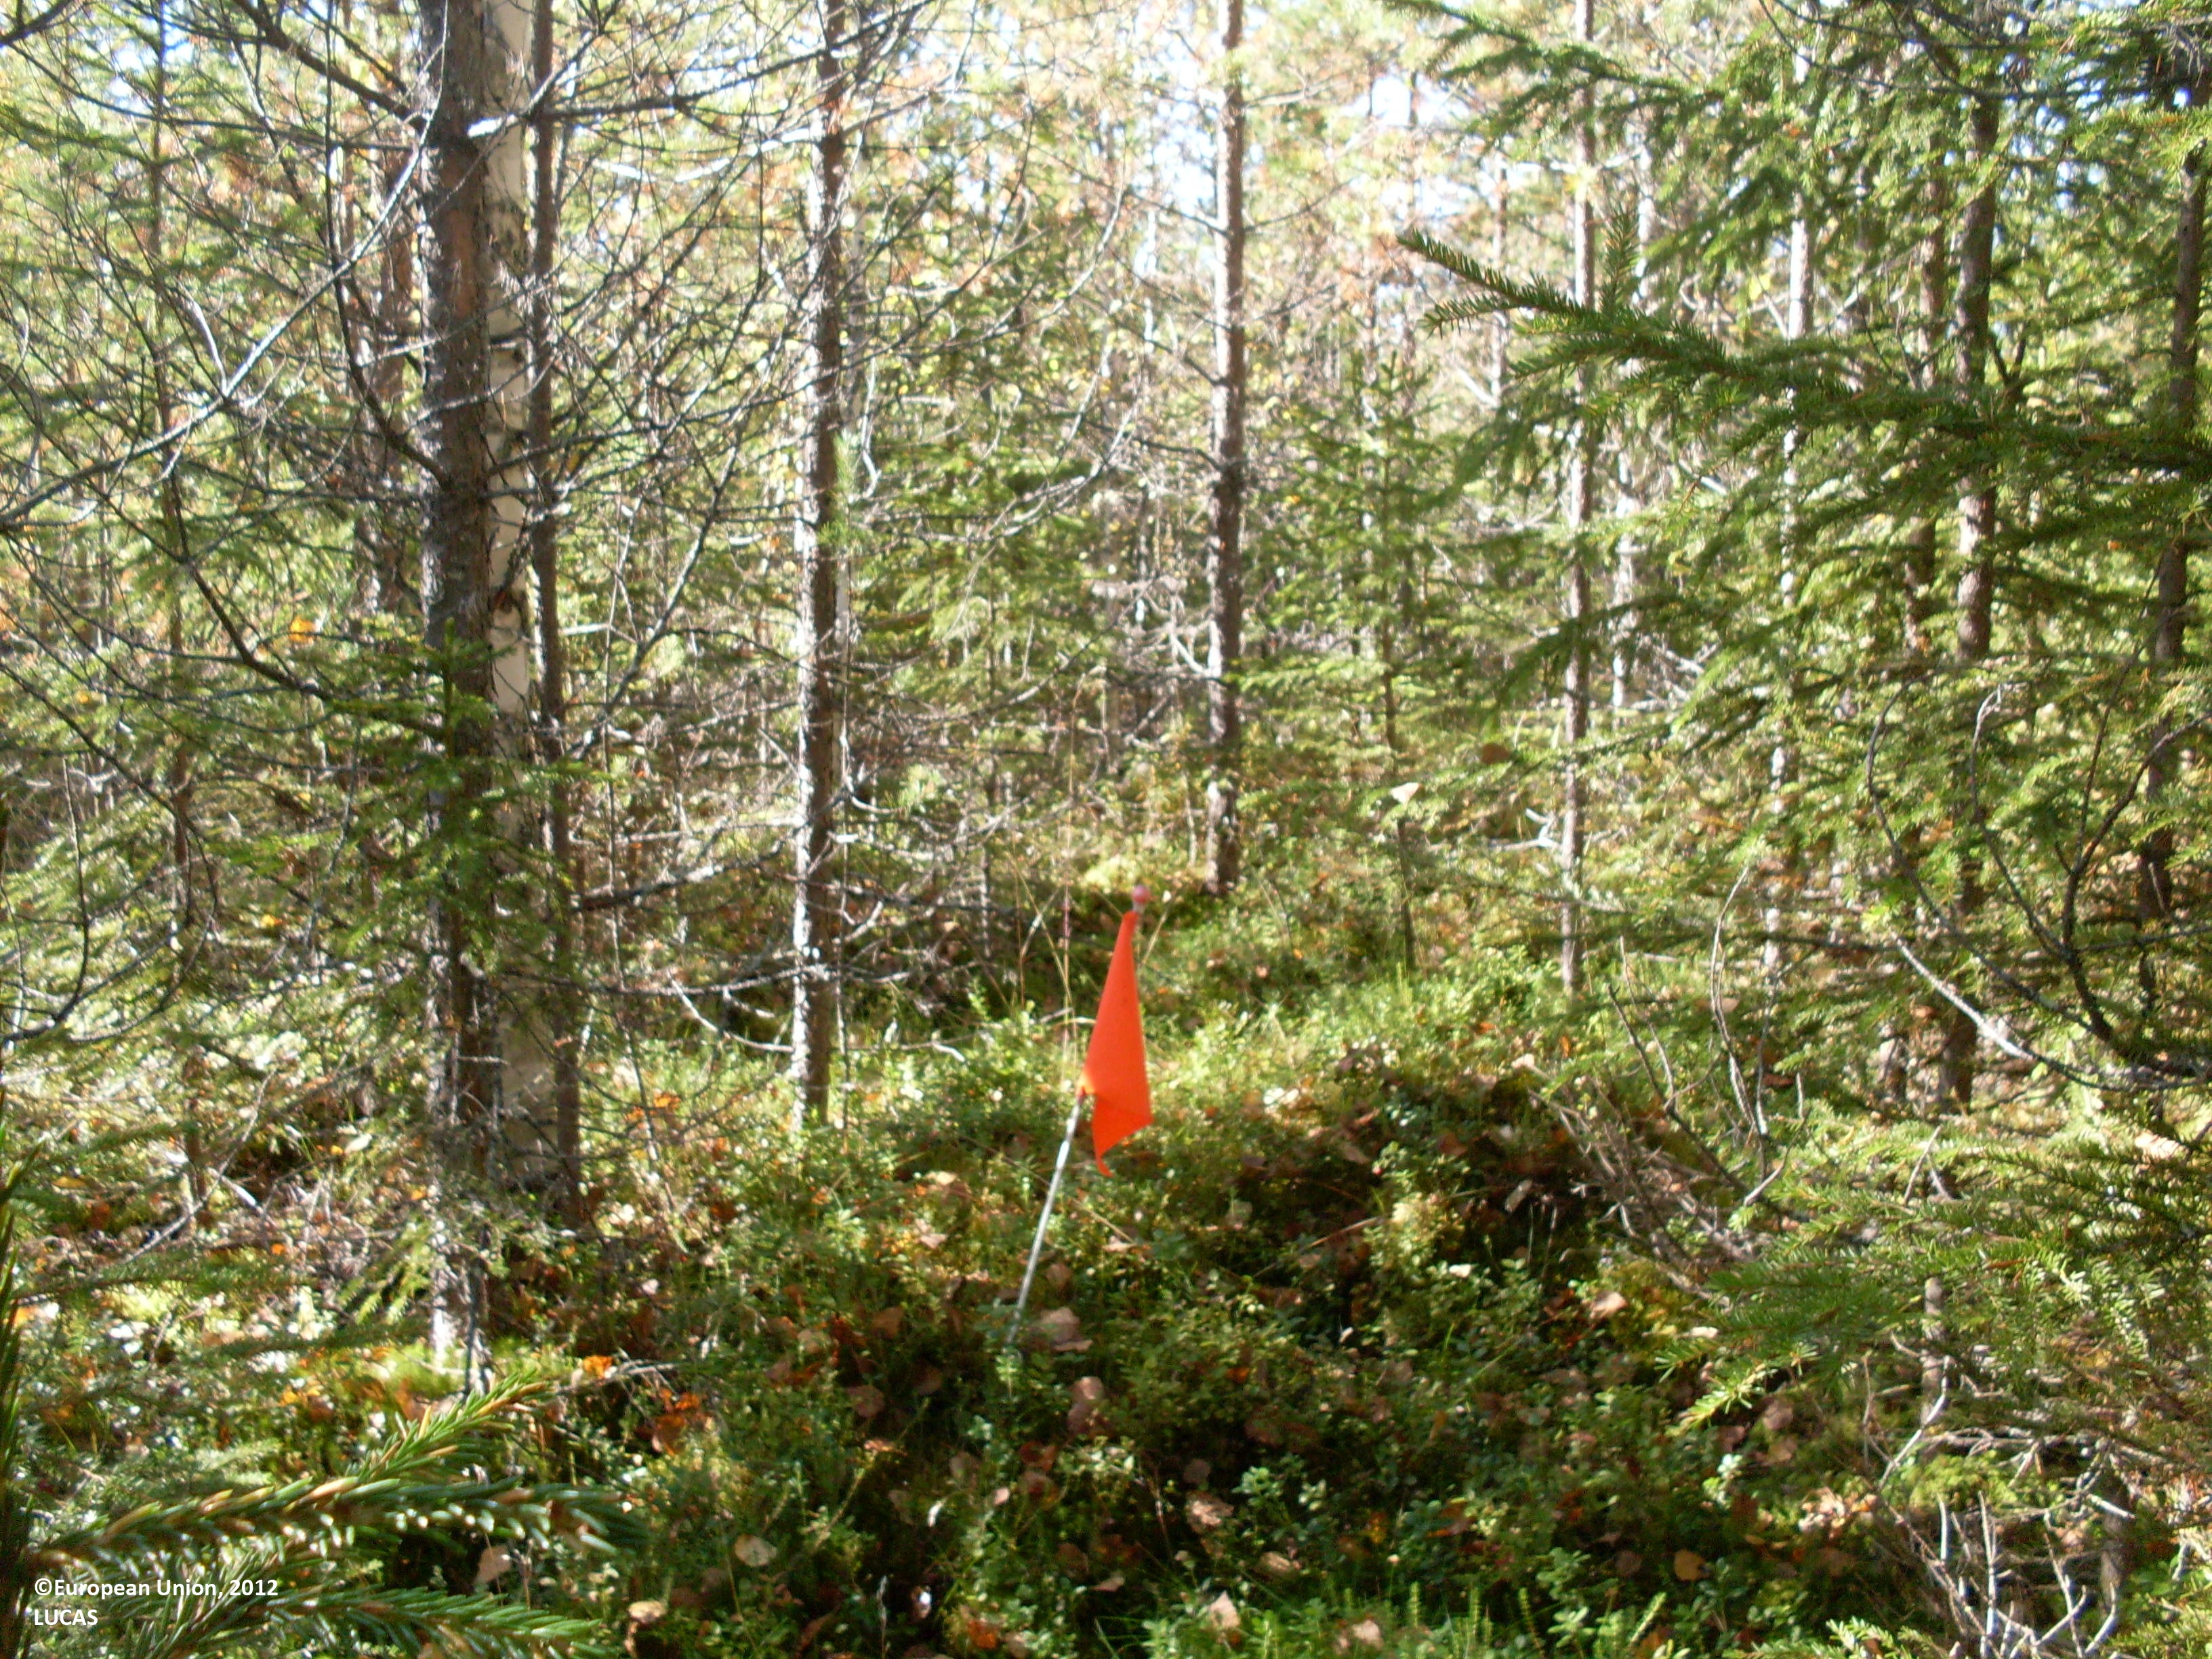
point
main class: Woodland
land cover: Spruce dominated mixed woodland
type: boreal forest
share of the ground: > 75 %
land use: Forestry
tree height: > 5 m
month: September
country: FI
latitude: 64.0446
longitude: 29.2339
